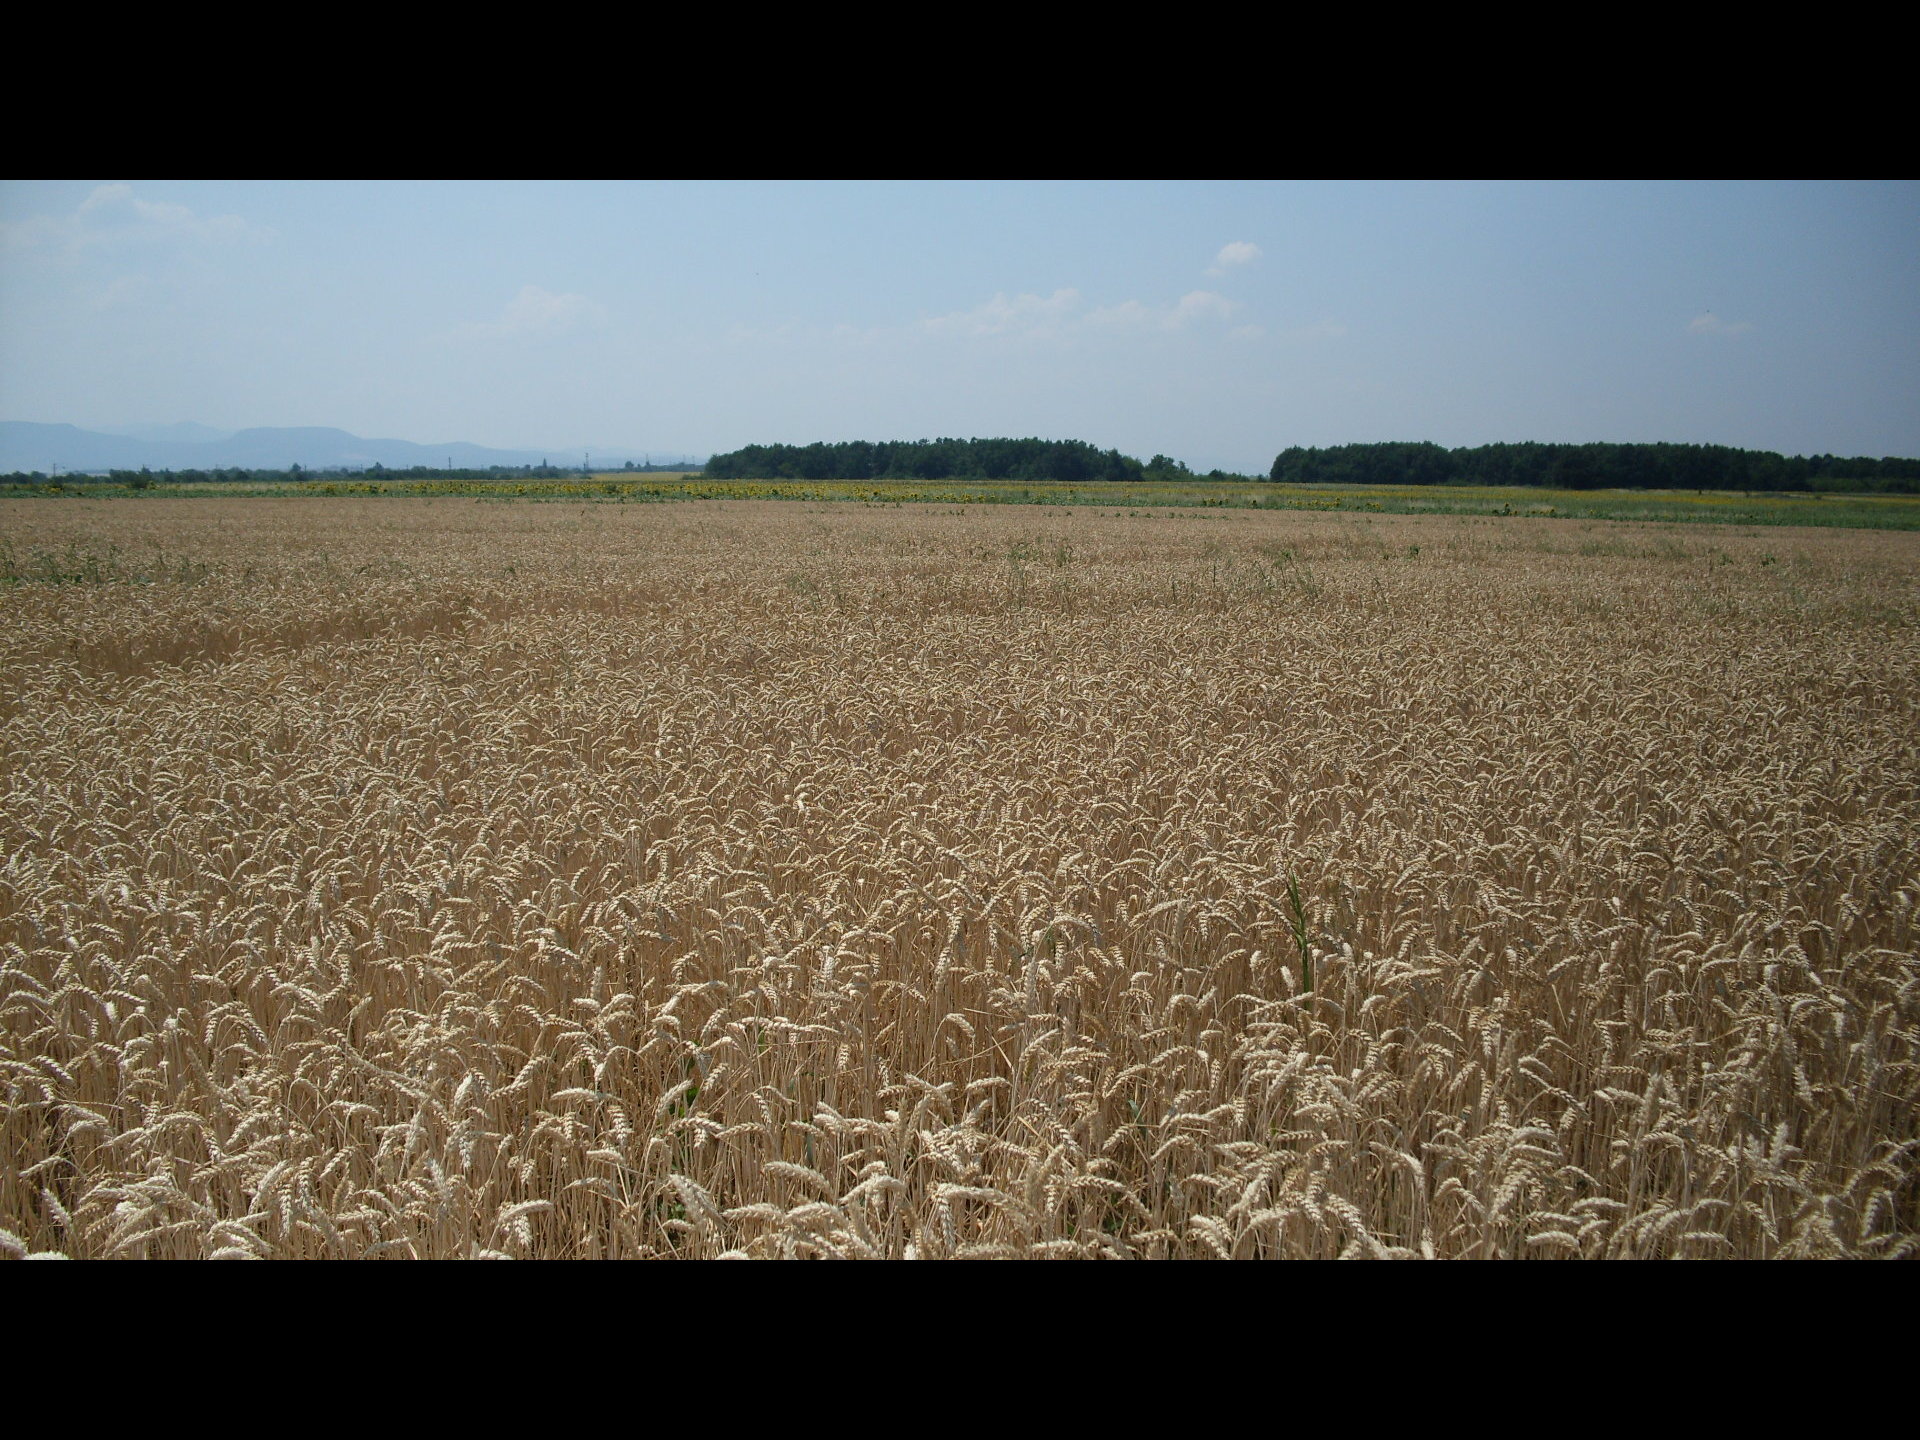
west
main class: Cropland
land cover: Common wheat
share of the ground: > 75 %
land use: Agriculture (excluding fallow land and kitchen gardens)
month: July
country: BG
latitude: 43.7081
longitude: 22.8818
